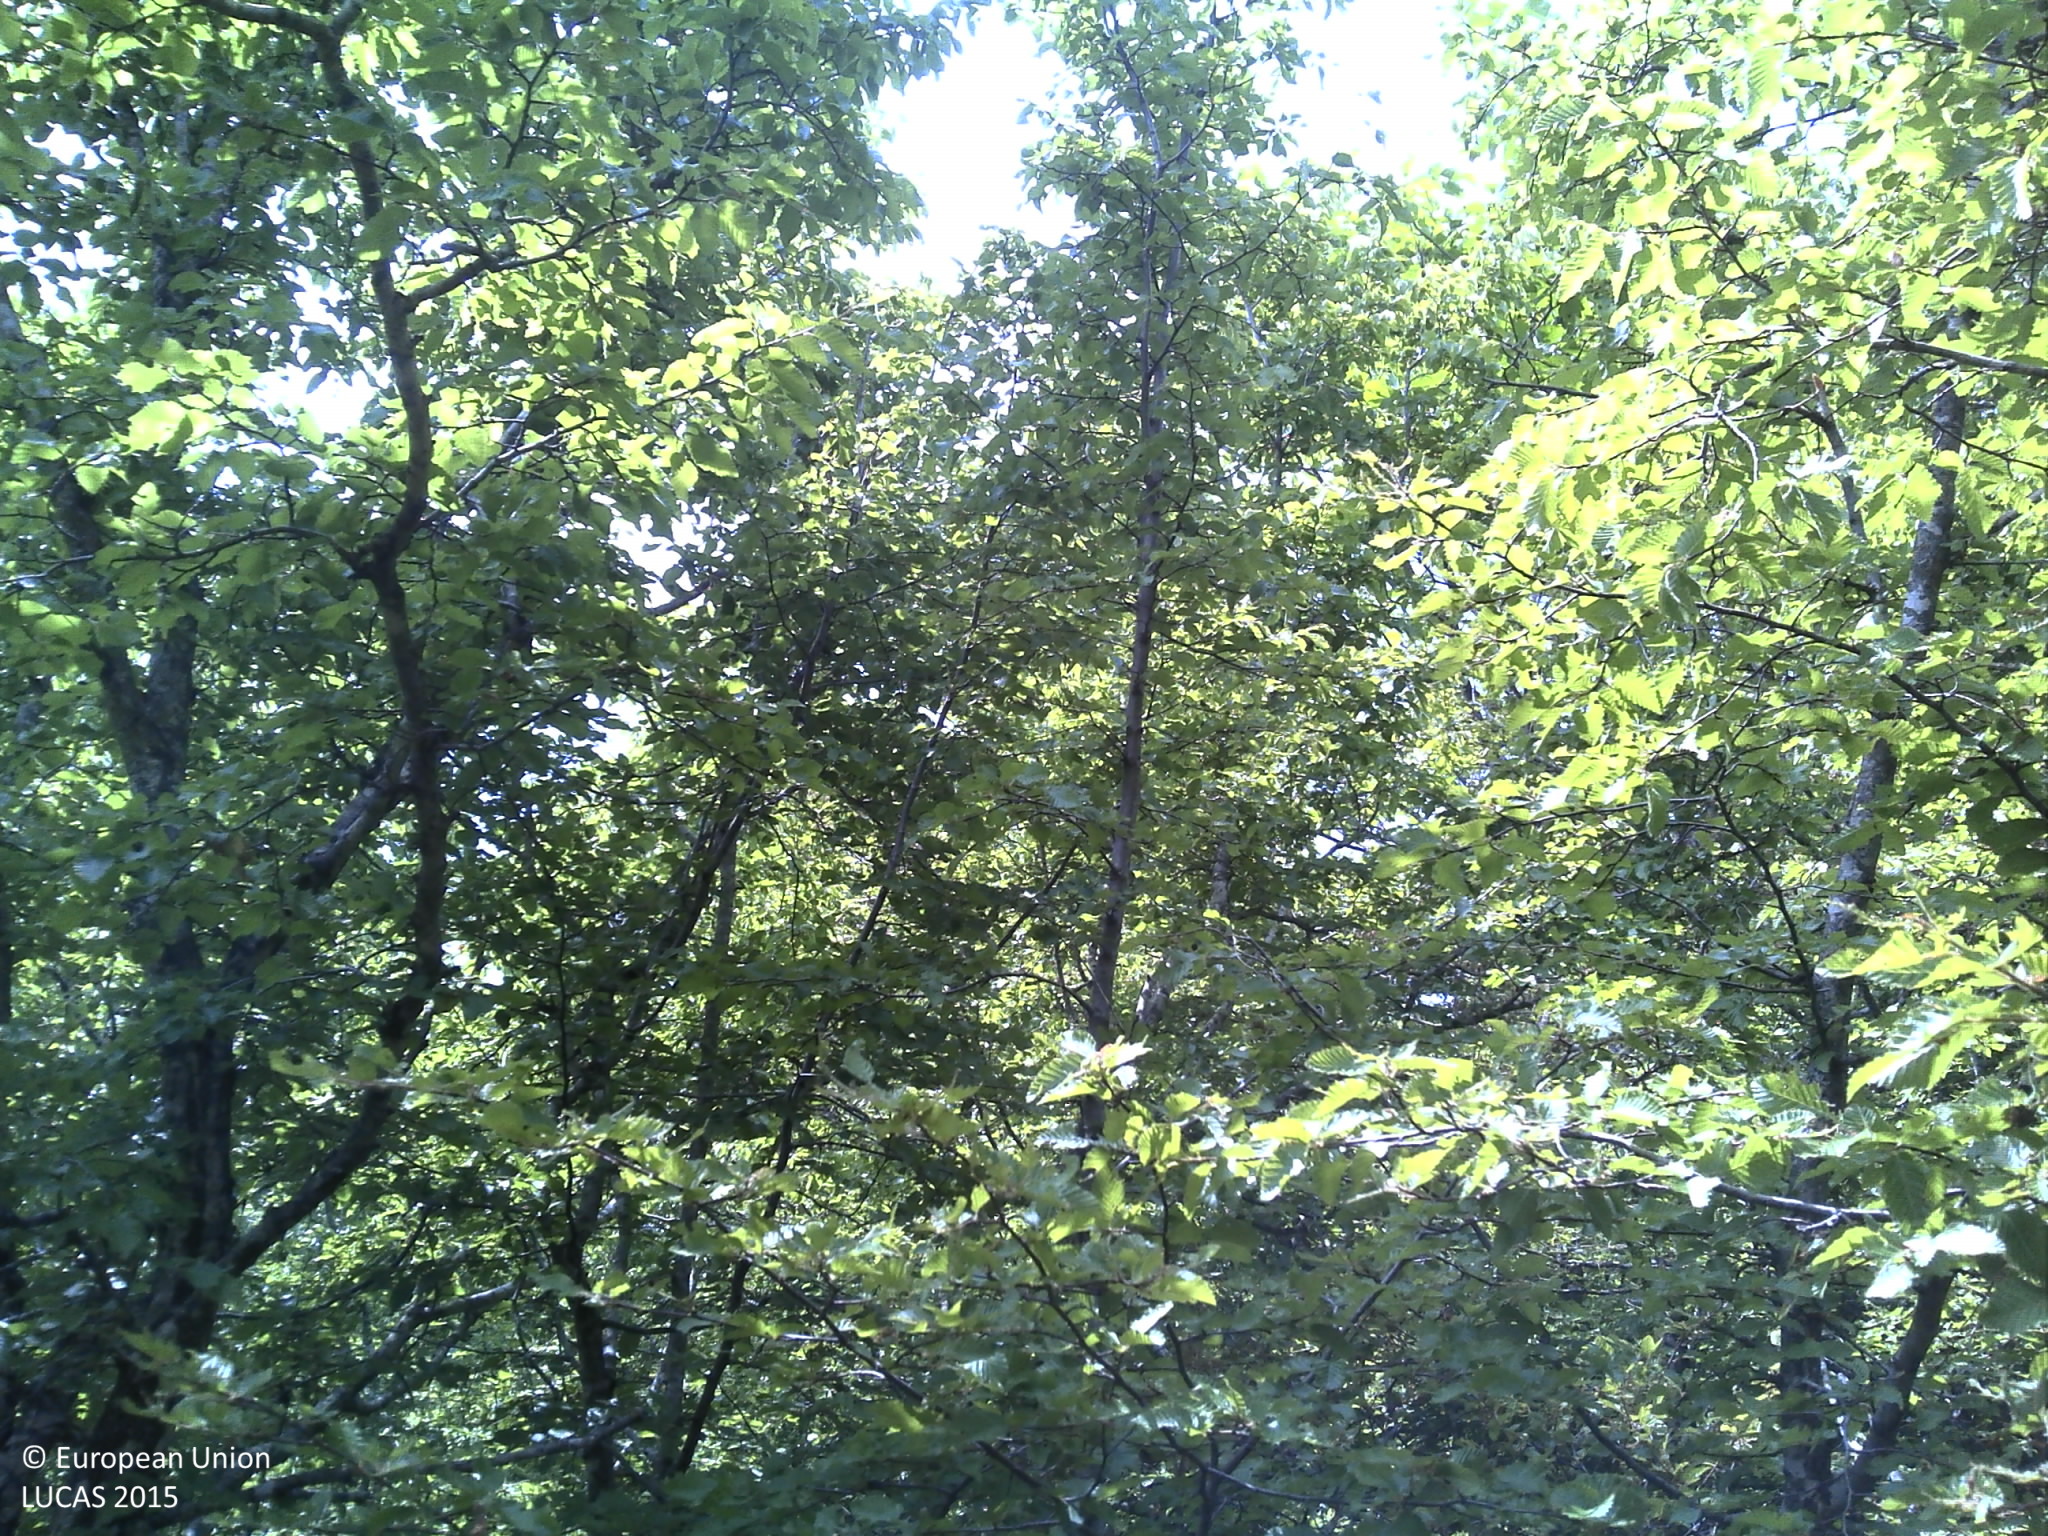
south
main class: Woodland
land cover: Broadleaved woodland
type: beech forest
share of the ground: 50 - 75 %
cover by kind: broadleaved forest trees 65 %, shrubs 25 %, consolidated bare surface 10 %
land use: Semi-natural and natural areas not in use
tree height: > 5 m
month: June
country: HR
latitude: 44.4071
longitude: 16.0839
